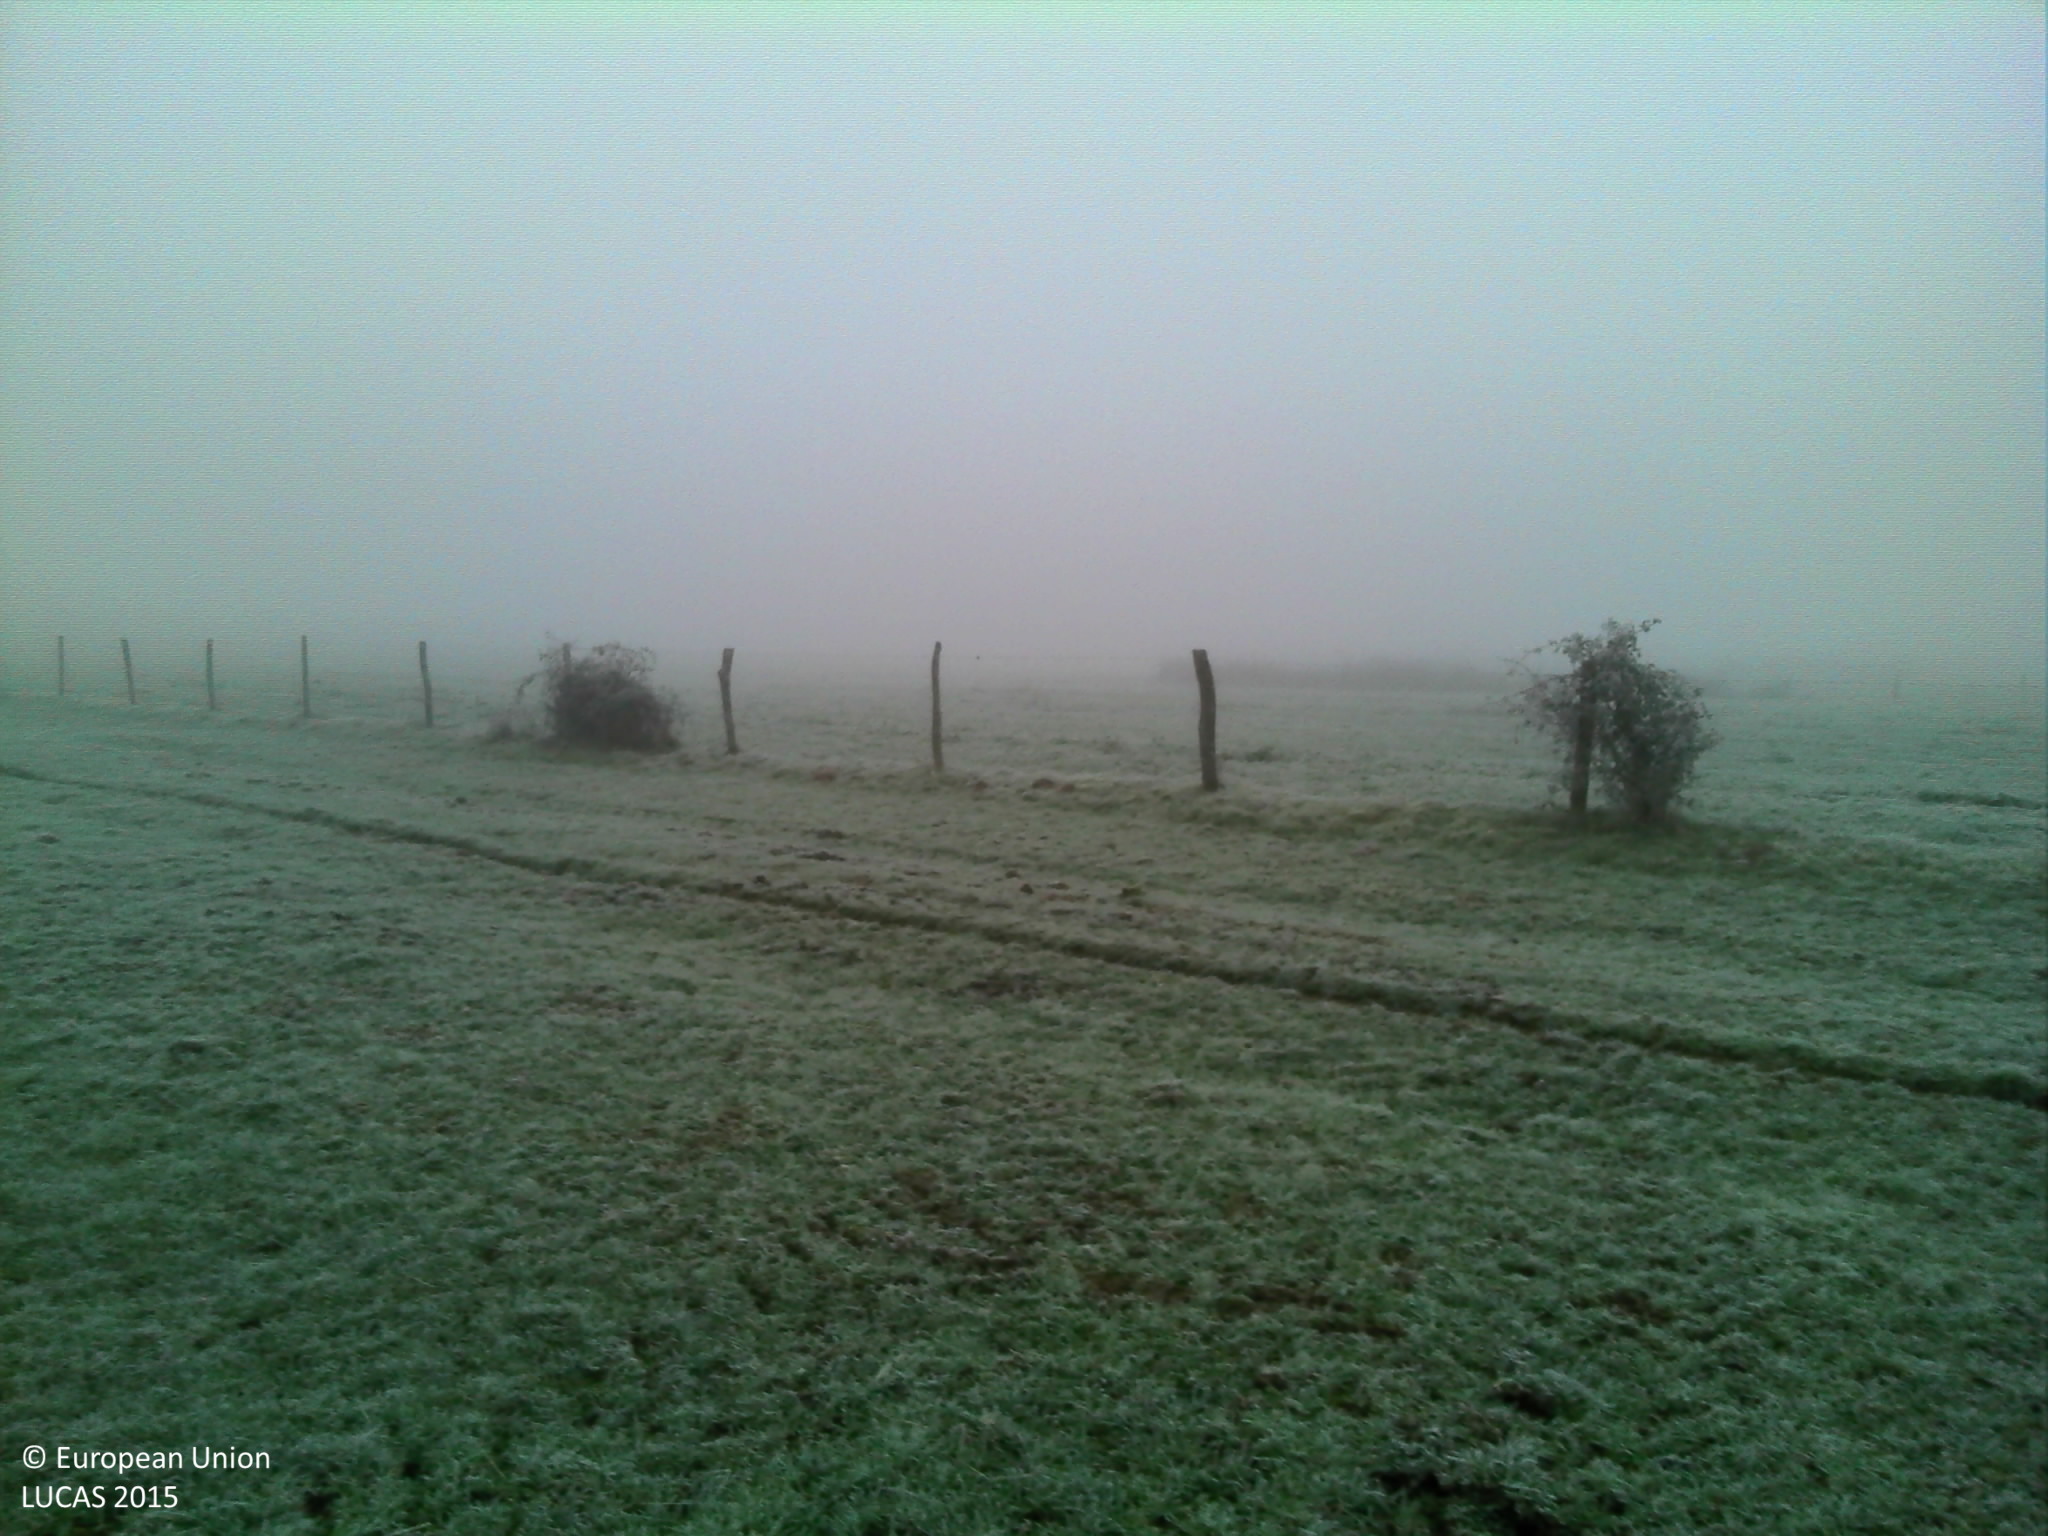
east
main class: Grassland
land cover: Grassland without tree/shrub cover
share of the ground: > 75 %
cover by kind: herbaceous plants 100 %
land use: Agriculture (excluding fallow land and kitchen gardens)
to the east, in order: Grassland without tree/shrub cover; Fences; Grassland without tree/shrub cover; Fences; Grassland without tree/shrub cover; Fences; Grassland without tree/shrub cover; Fences; Abandoned hedges; Grass margins; Ditches and canals; Grass margins; Common wheat
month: November
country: FR
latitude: 46.5925
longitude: 3.5902
